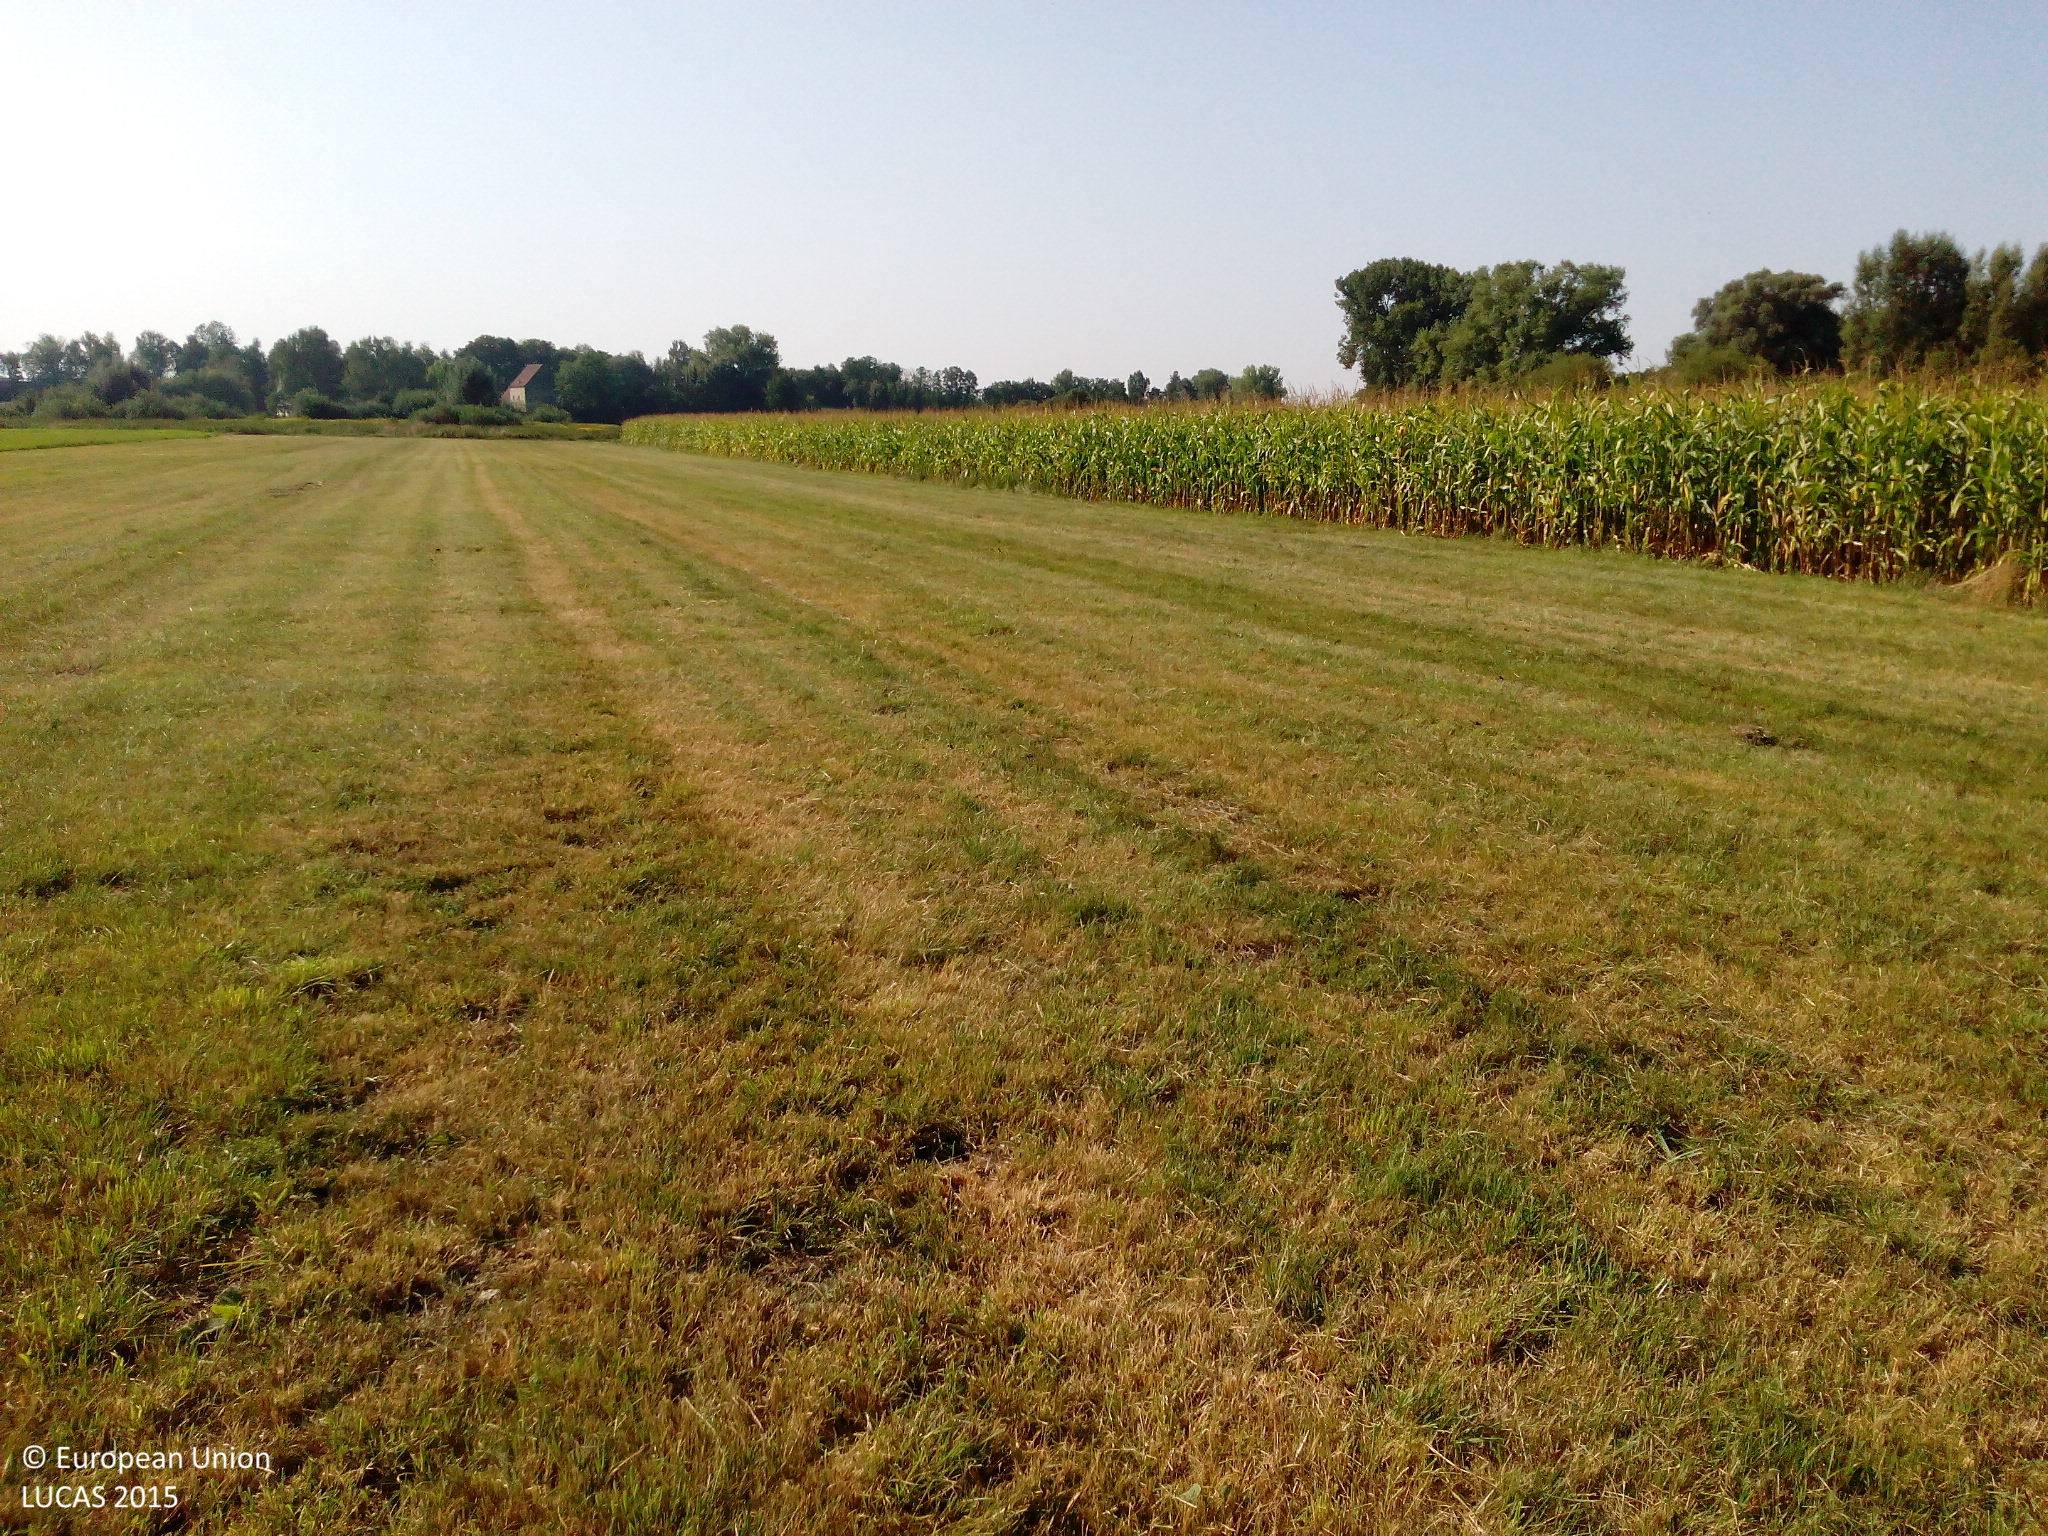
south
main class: Grassland
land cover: Grassland without tree/shrub cover
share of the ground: > 75 %
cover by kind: herbaceous plants 90 %, unconsolidated bare surface 10 %
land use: Agriculture (excluding fallow land and kitchen gardens)
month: September
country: DE
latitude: 48.7049
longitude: 10.9915
